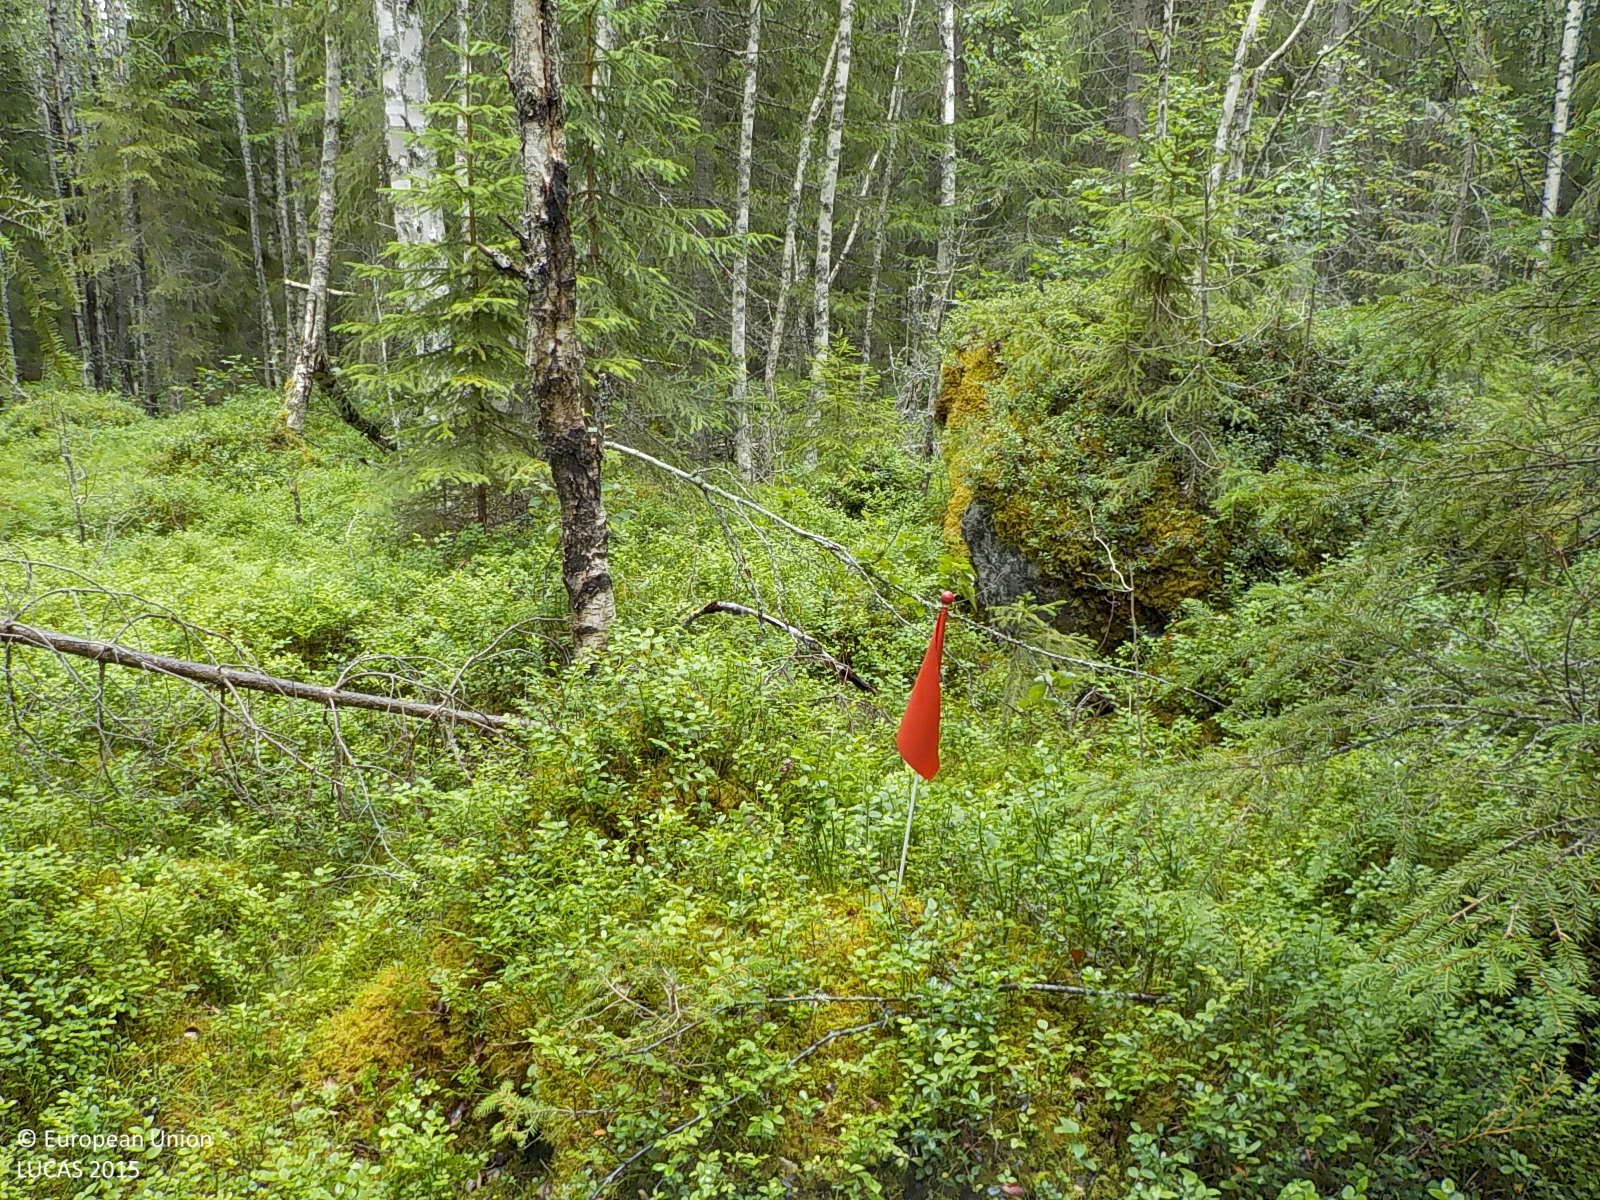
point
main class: Woodland
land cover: Other mixed woodland
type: boreal forest
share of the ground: > 75 %
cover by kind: coniferous forest trees 50 %, broadleaved forest trees 30 %, shrubs 10 %, lichens and mosses 5 %, consolidated bare surface 5 %
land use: Forestry
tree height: > 5 m
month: July
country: SE
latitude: 63.3430
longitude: 17.2668
